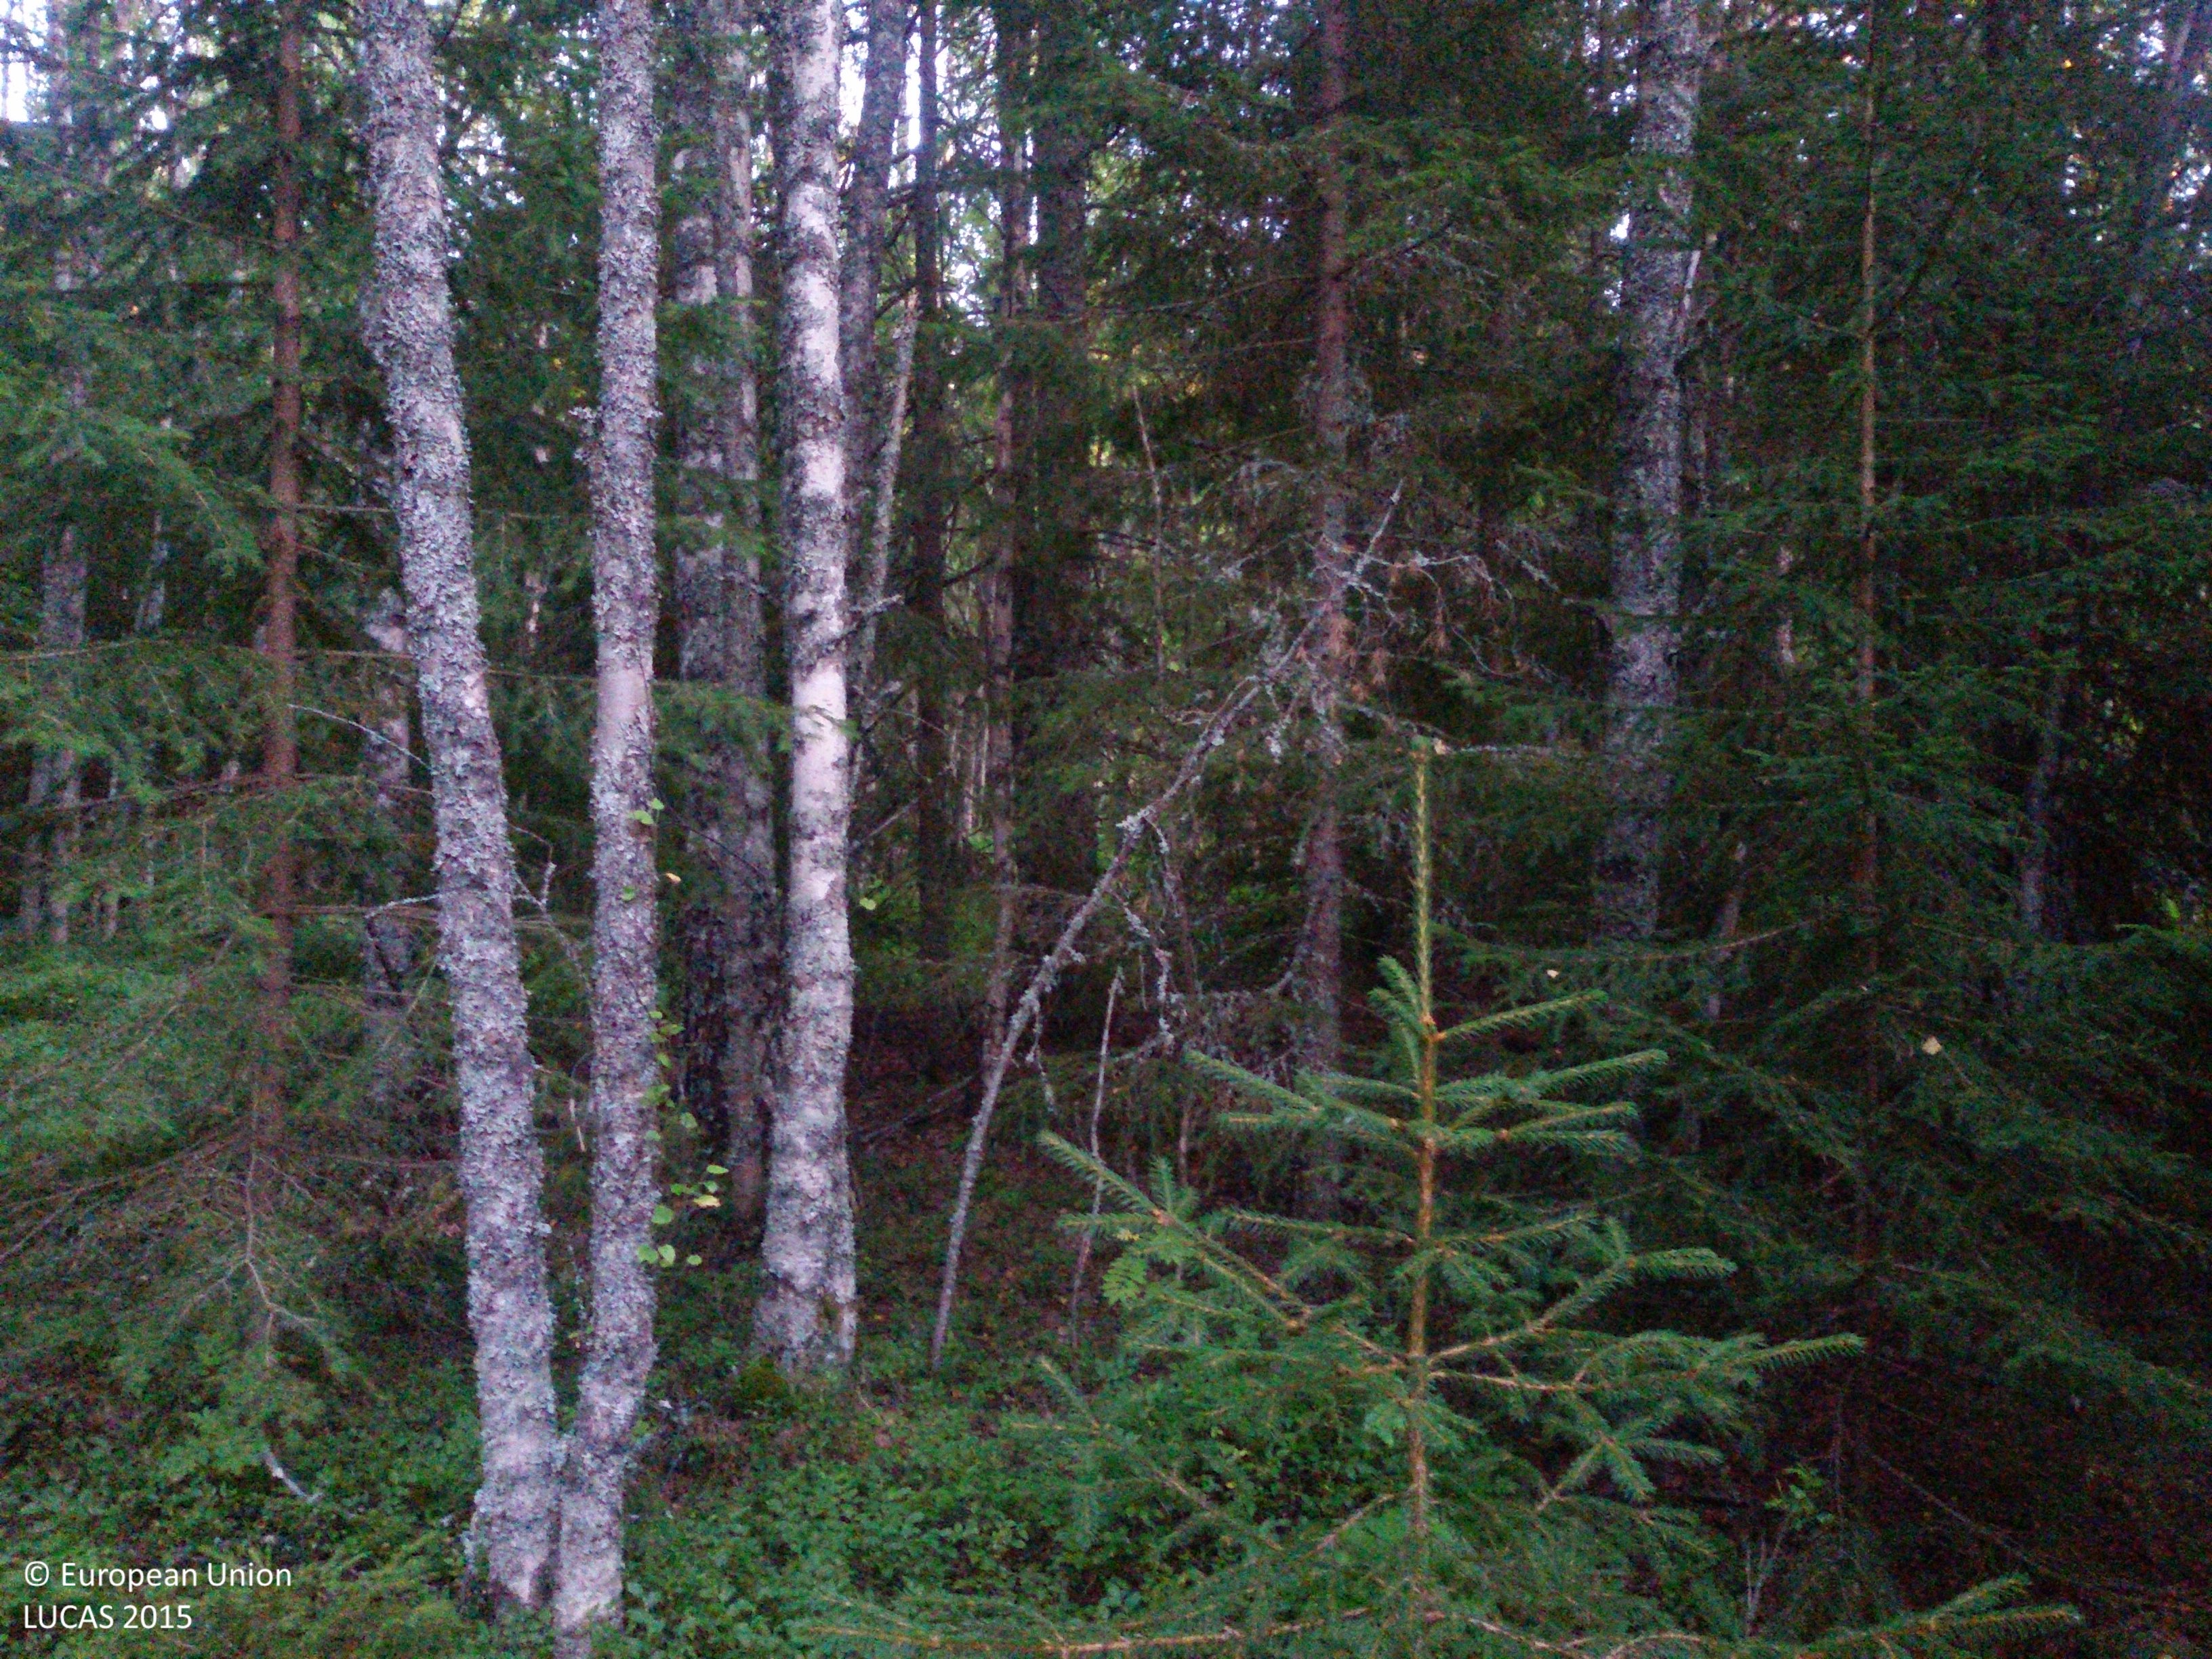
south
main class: Woodland
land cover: Spruce dominated mixed woodland
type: boreal forest
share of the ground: > 75 %
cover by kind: coniferous forest trees 40 %, broadleaved forest trees 40 %, shrubs 10 %, lichens and mosses 10 %
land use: Forestry
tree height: > 5 m
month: August
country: SE
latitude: 60.7618
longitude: 15.4378
